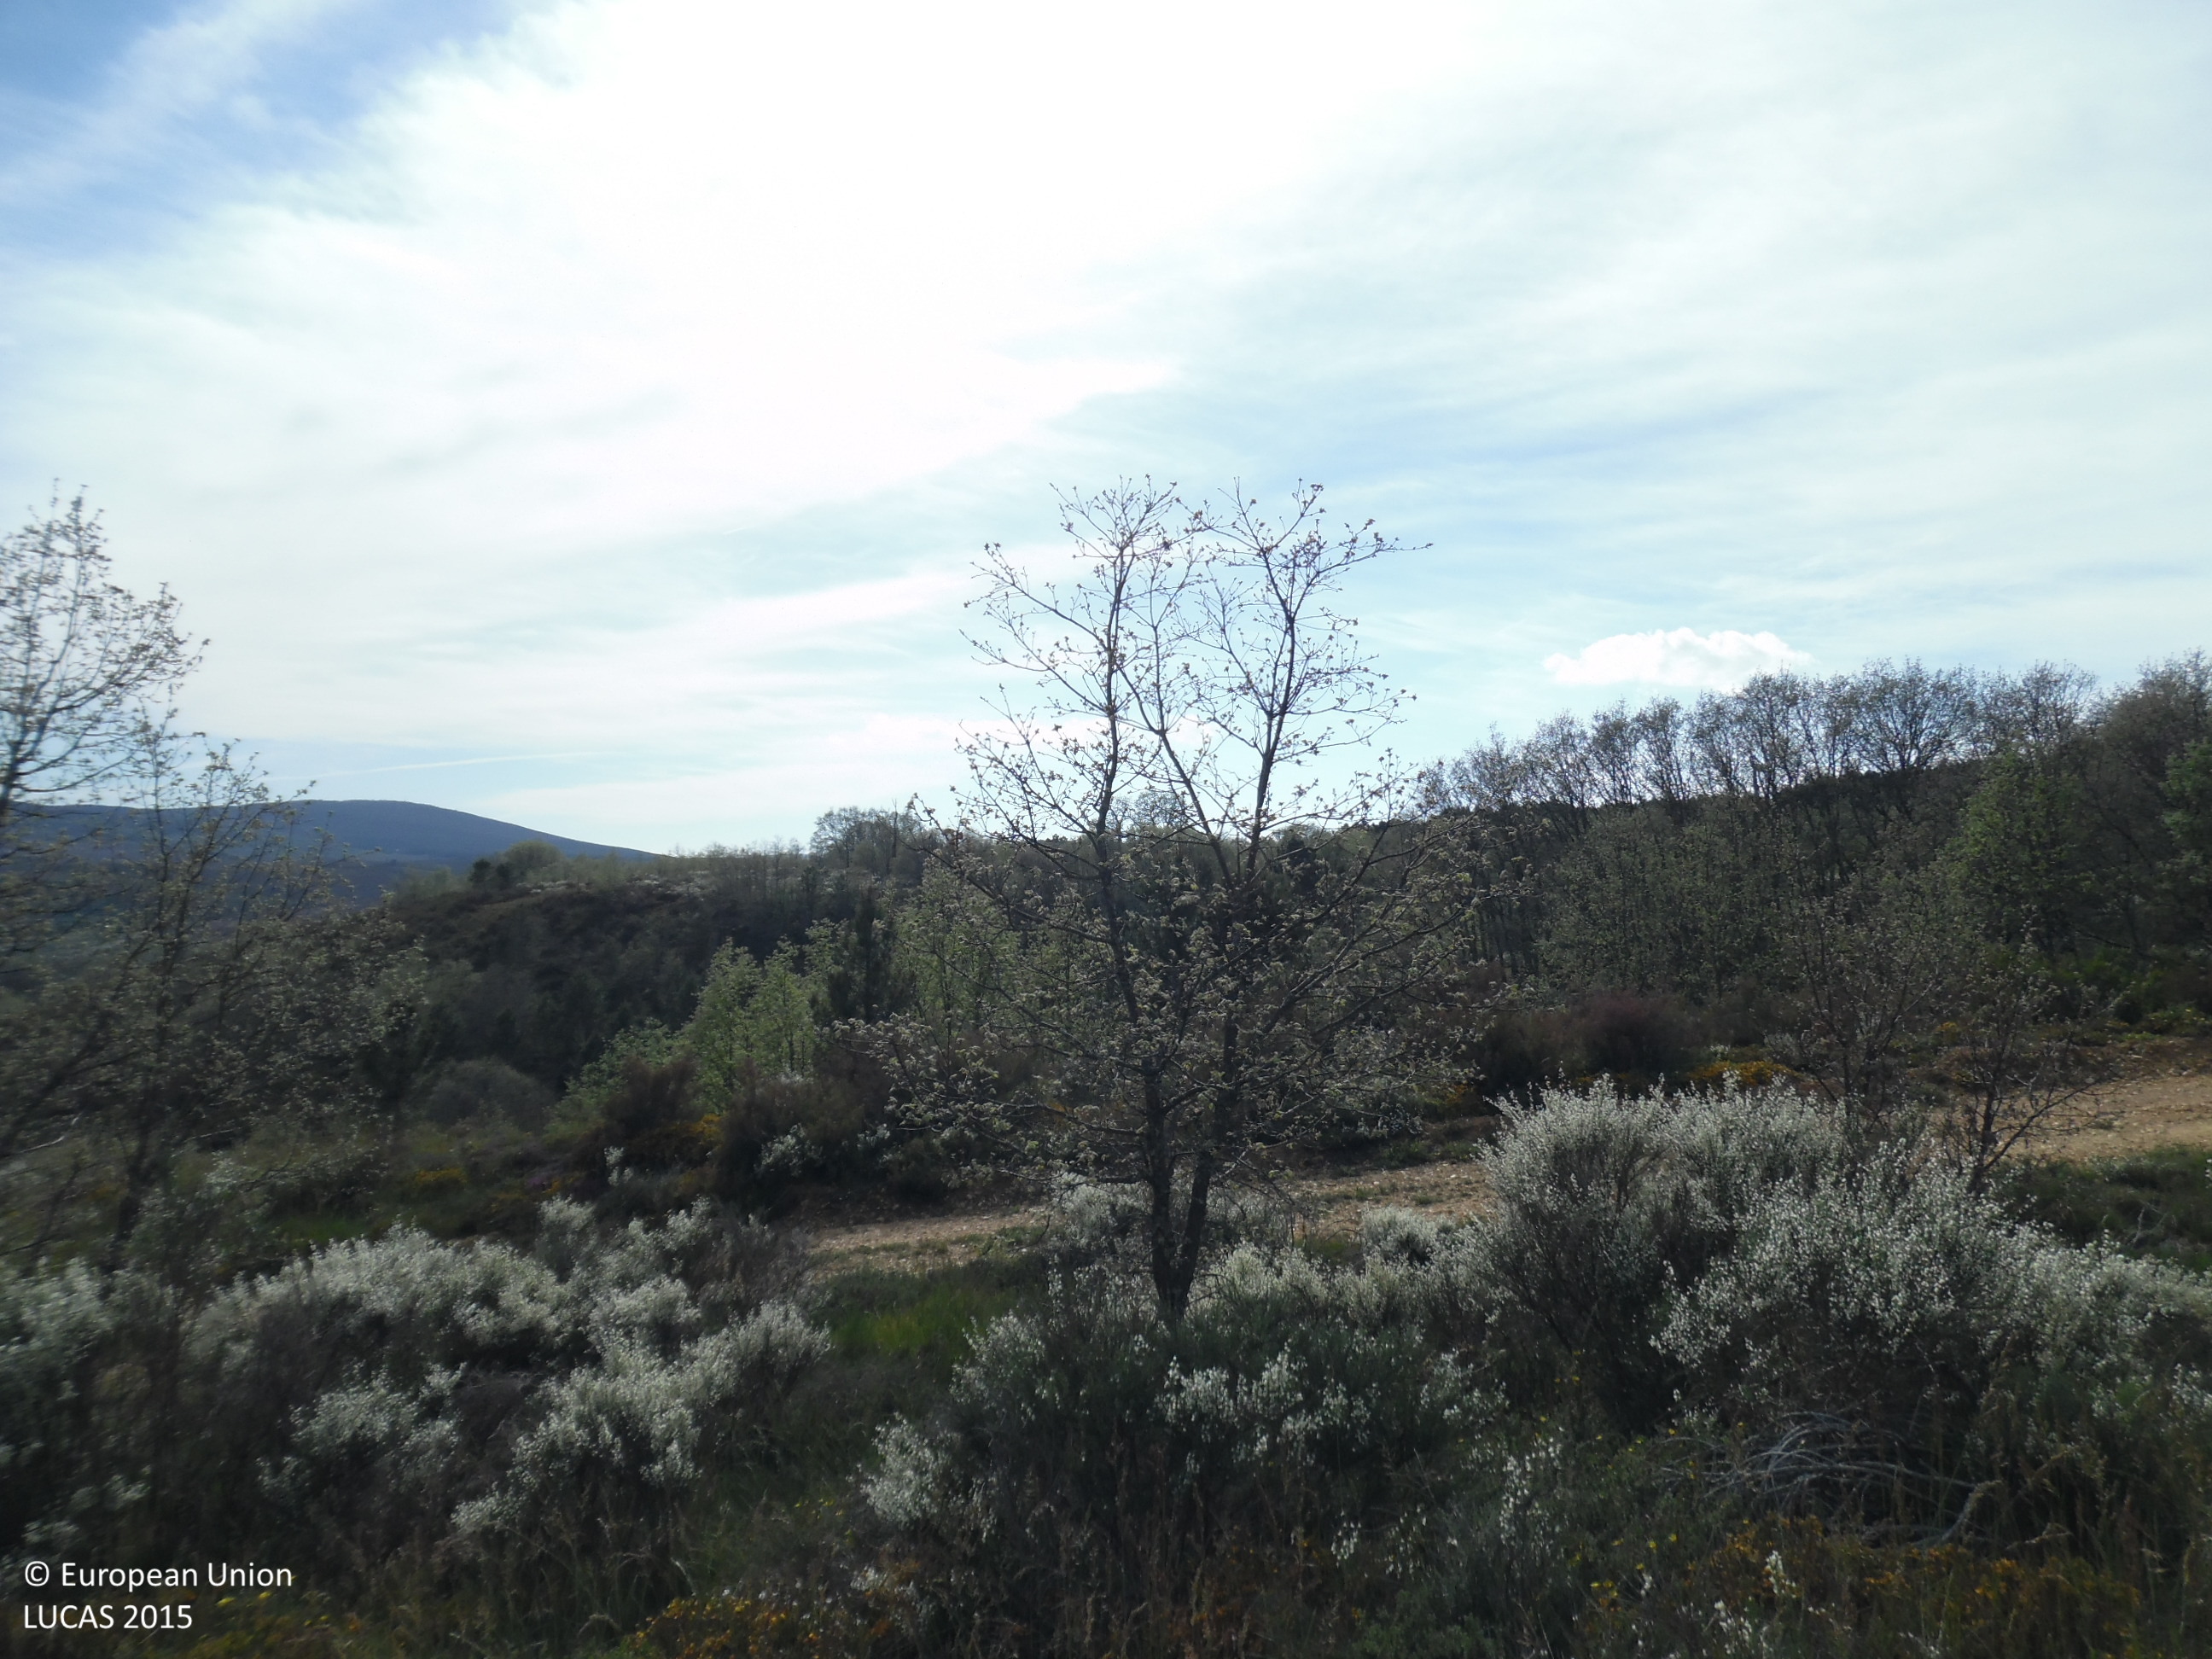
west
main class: Shrubland
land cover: Shrubland without tree cover
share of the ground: > 75 %
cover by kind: shrubs 100 %
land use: Semi-natural and natural areas not in use
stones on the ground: < 10 %
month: May
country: ES
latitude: 42.6037
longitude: -6.1128
